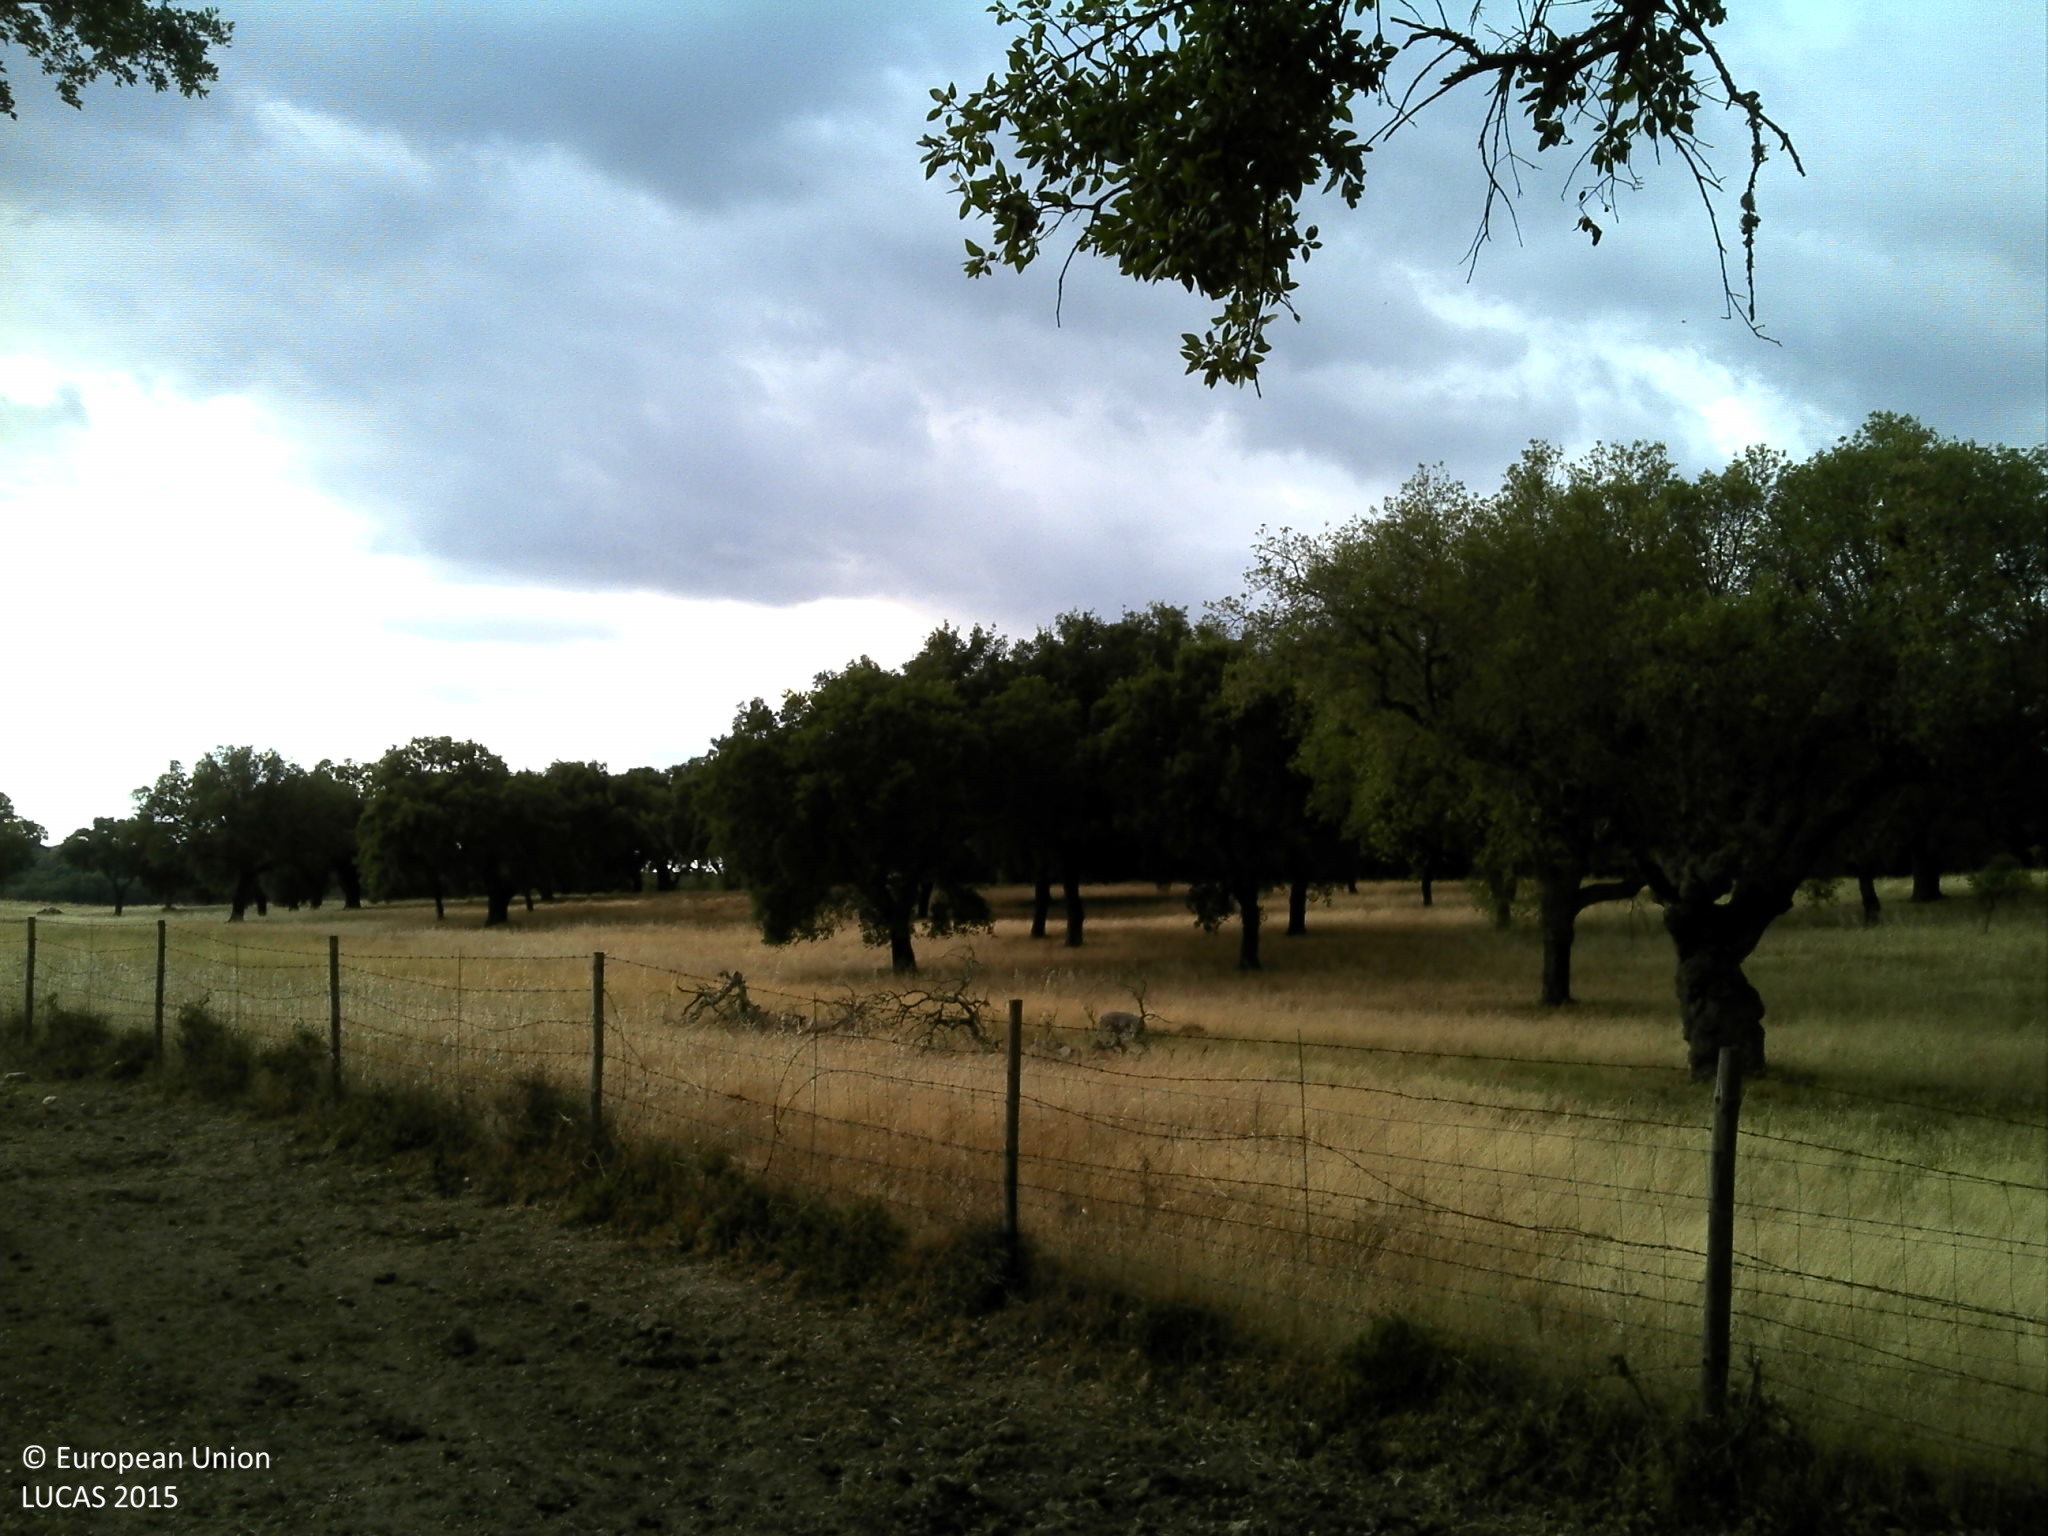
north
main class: Woodland
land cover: Broadleaved woodland
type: broadleaved evergreen forest
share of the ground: 25 - 50 %
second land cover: Grassland without tree/shrub cover
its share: < 10 %
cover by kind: unconsolidated bare surface 50 %, broadleaved forest trees 40 %, herbaceous plants 10 %
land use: Forestry
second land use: Agriculture (excluding fallow land and kitchen gardens)
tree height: > 5 m
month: June
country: PT
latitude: 38.5773
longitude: -8.1474
